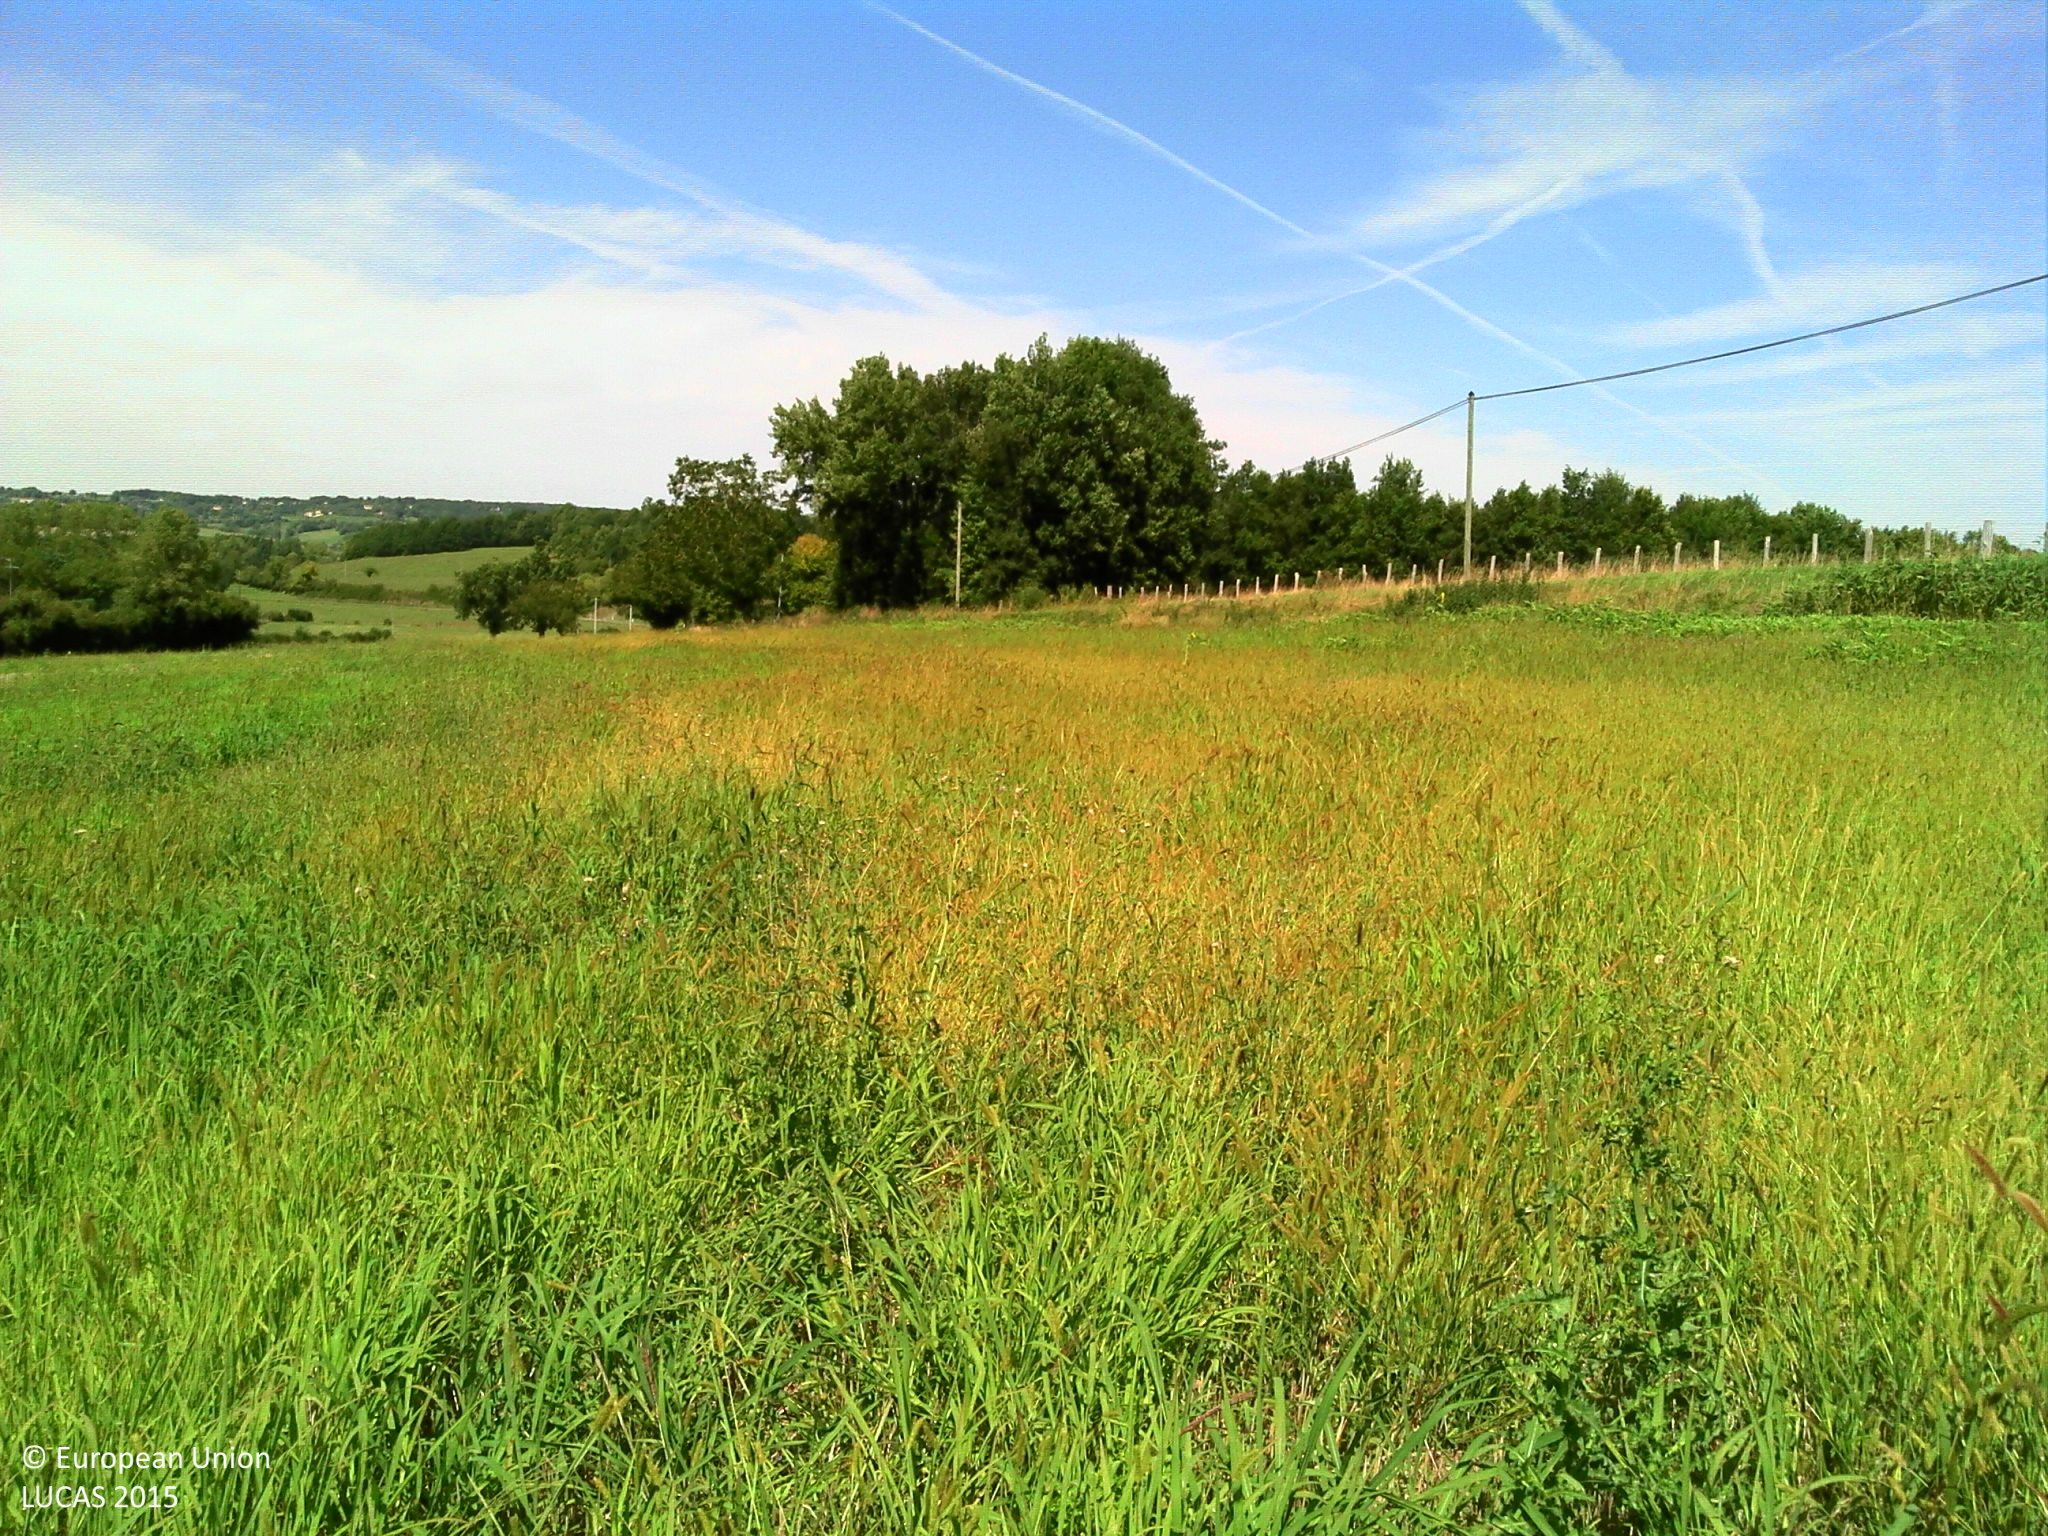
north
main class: Grassland
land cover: Grassland without tree/shrub cover
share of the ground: > 75 %
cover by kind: herbaceous plants 100 %
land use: Agriculture (excluding fallow land and kitchen gardens)
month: August
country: FR
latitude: 45.2382
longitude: 0.4979
